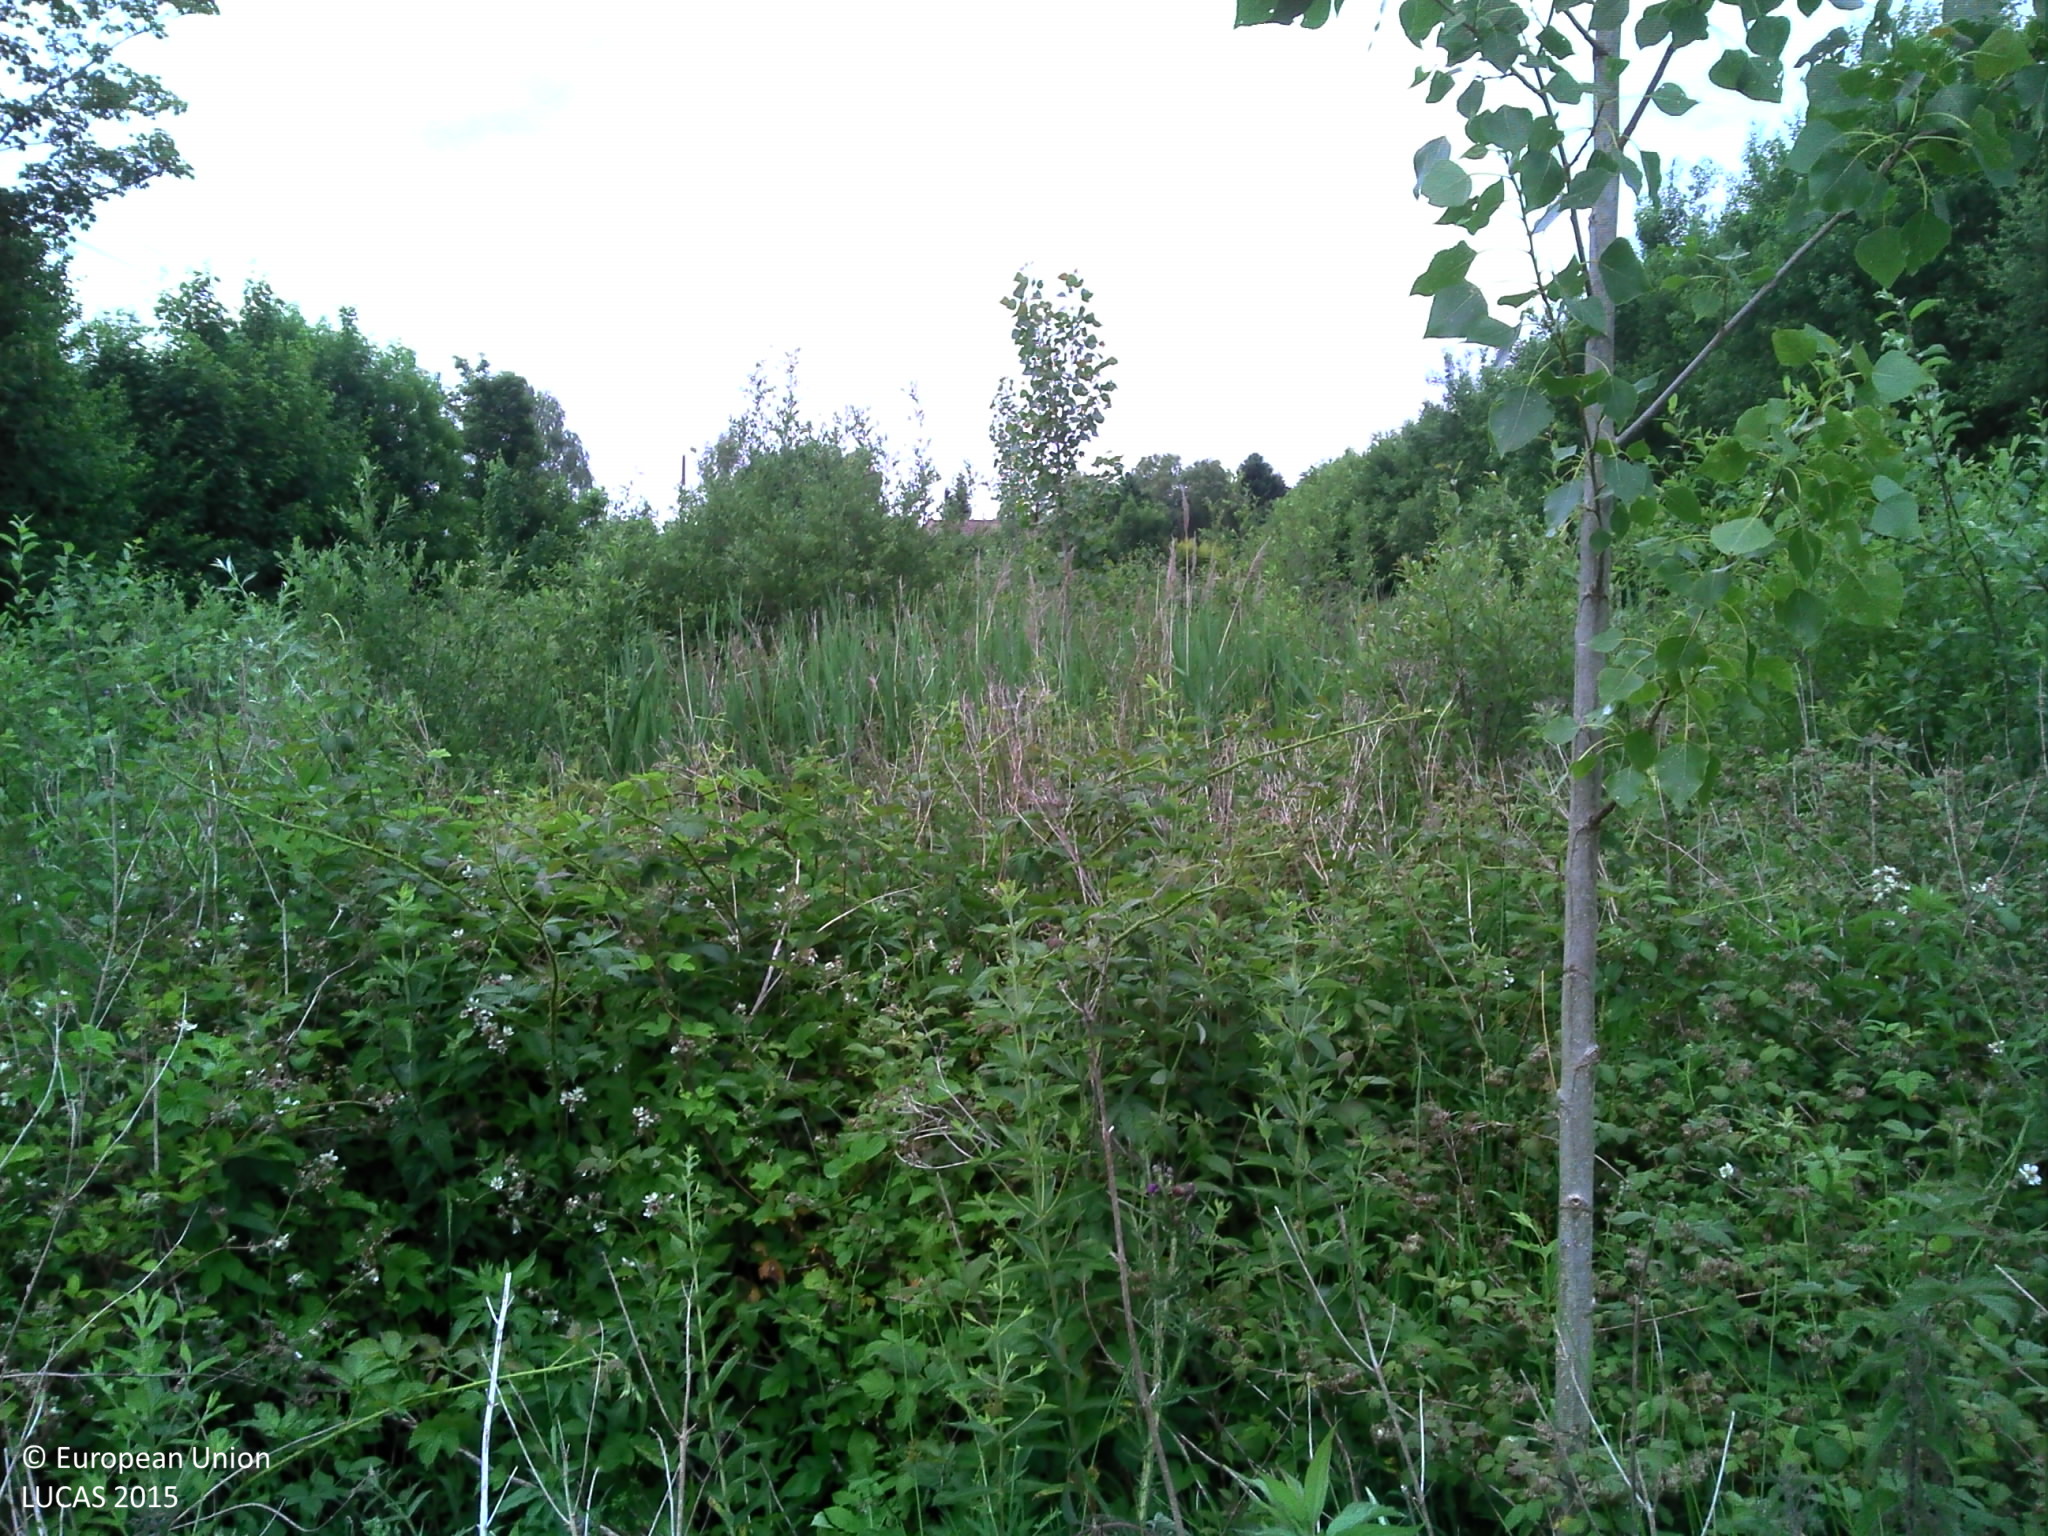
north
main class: Shrubland
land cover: Shrubland with sparse tree cover
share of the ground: > 75 %
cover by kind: shrubs 70 %, herbaceous plants 25 %, broadleaved forest trees 5 %
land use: Semi-natural and natural areas not in use
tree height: < 5 m
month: June
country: BE
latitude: 50.5042
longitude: 3.8321
